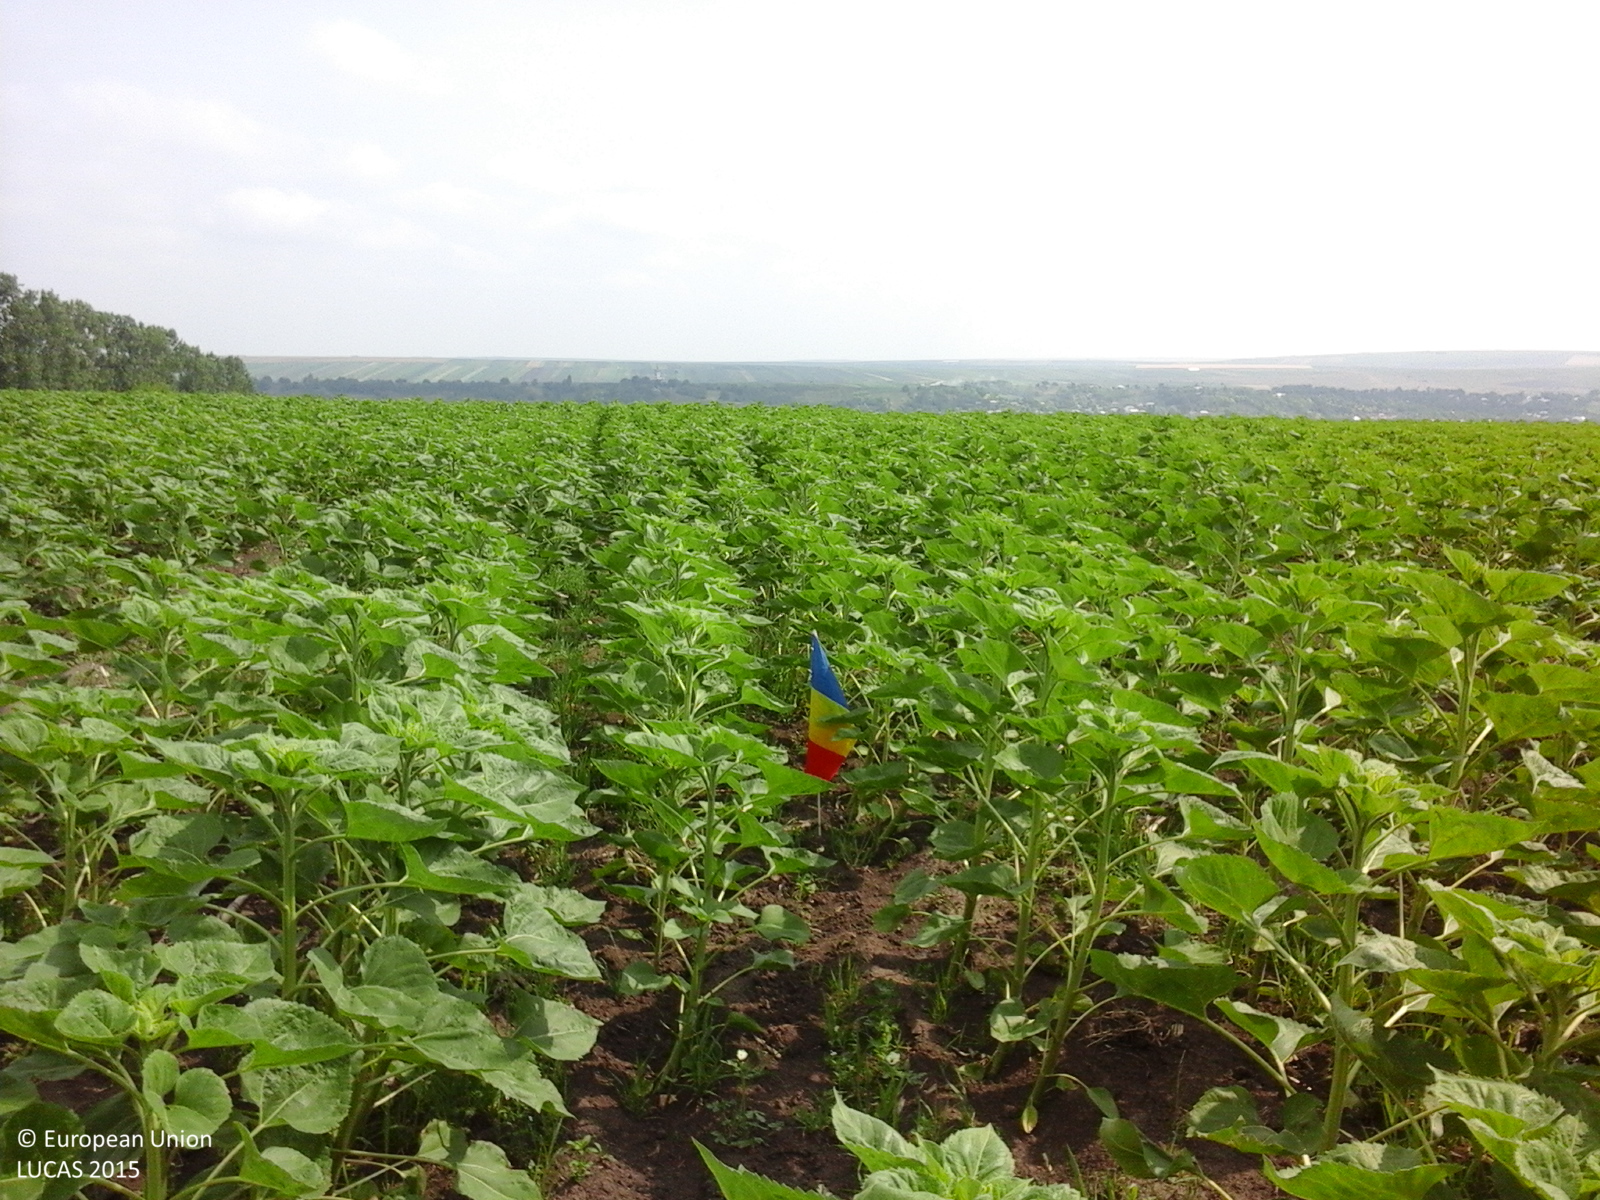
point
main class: Cropland
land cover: Sunflower
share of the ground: > 75 %
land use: Agriculture (excluding fallow land and kitchen gardens)
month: June
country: RO
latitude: 47.7888
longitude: 26.6606
